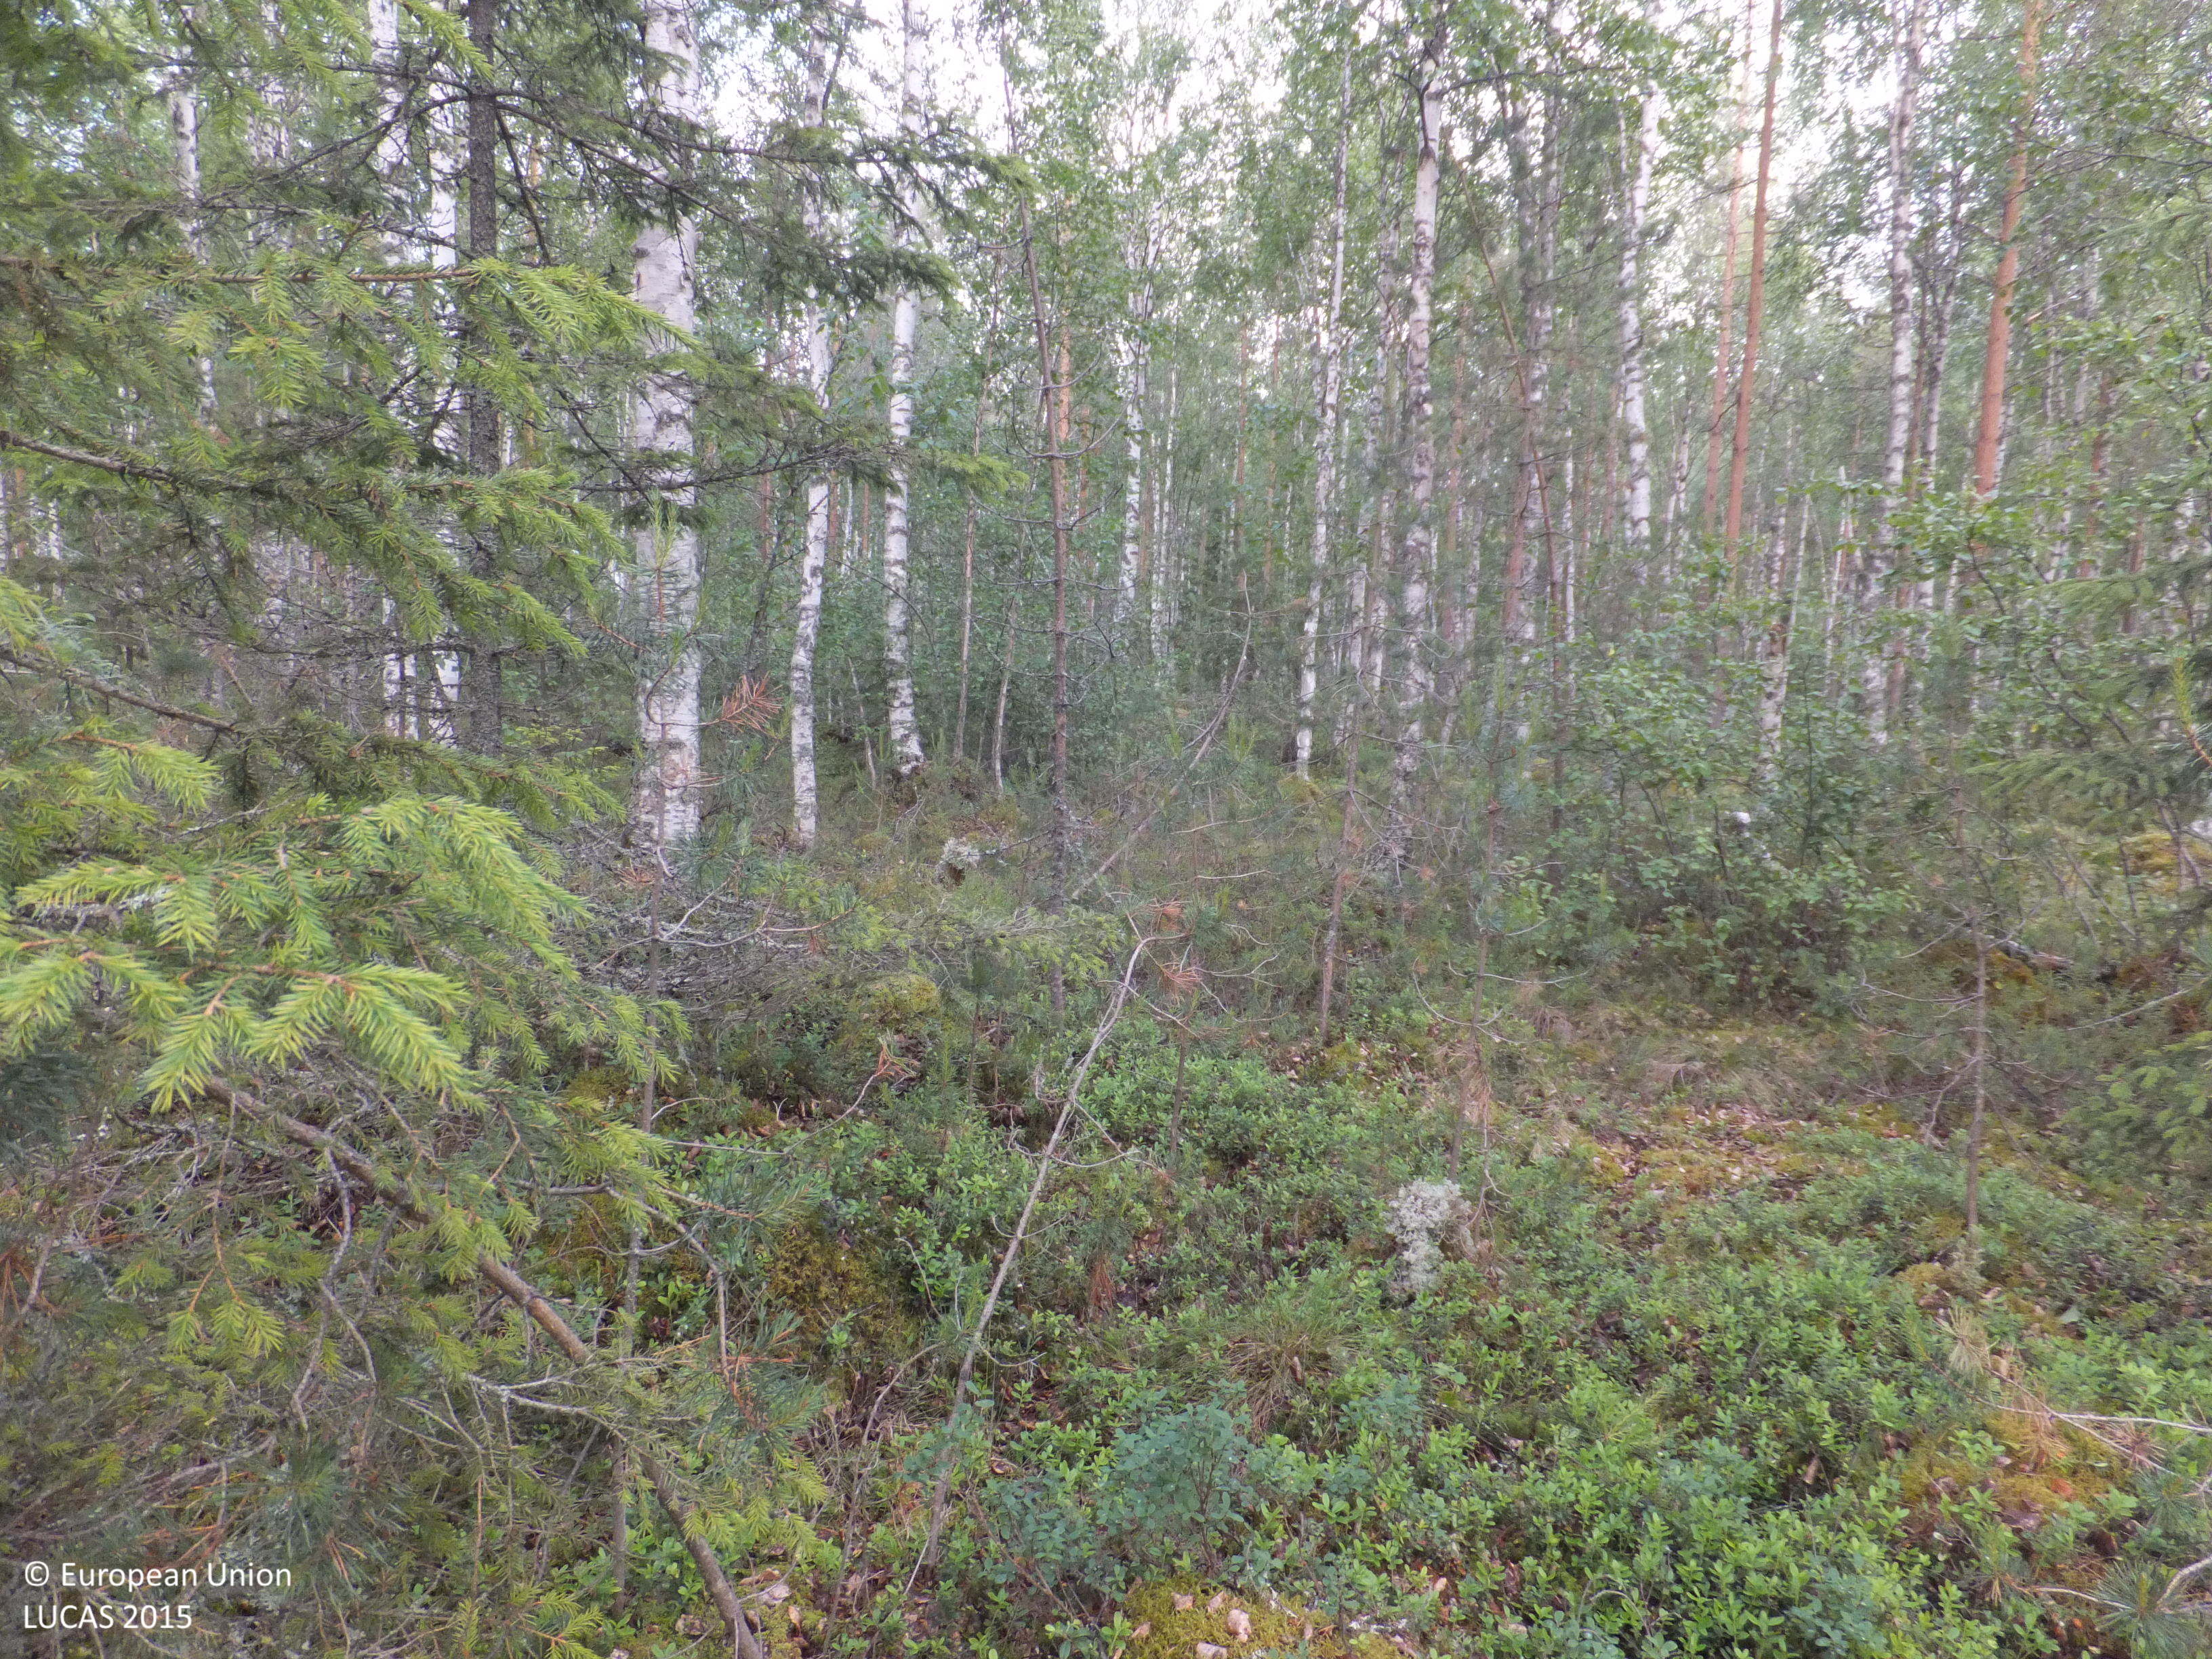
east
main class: Woodland
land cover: Pine dominated mixed woodland
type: boreal forest
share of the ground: > 75 %
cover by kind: broadleaved forest trees 60 %, coniferous forest trees 20 %, shrubs 10 %, lichens and mosses 10 %
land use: Forestry
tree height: > 5 m
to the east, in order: Pine dominated mixed woodland; Ditches and canals; Pine dominated mixed woodland; Broadleaved woodland; Ditches and canals; Spruce dominated mixed woodland; Broadleaved woodland; Ditches and canals; Broadleaved woodland; Grassland with sparse tree/shrub cover; Grassland without tree/shrub cover; Electric lines; Broadleaved woodland; Inland fresh running water; Lines of trees; Grassland without tree/shrub cover; Abandoned hedges; Ditches and canals; Grass margins; Paved roads, cycling and walking lanes
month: July
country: FI
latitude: 63.0108
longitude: 24.4829
